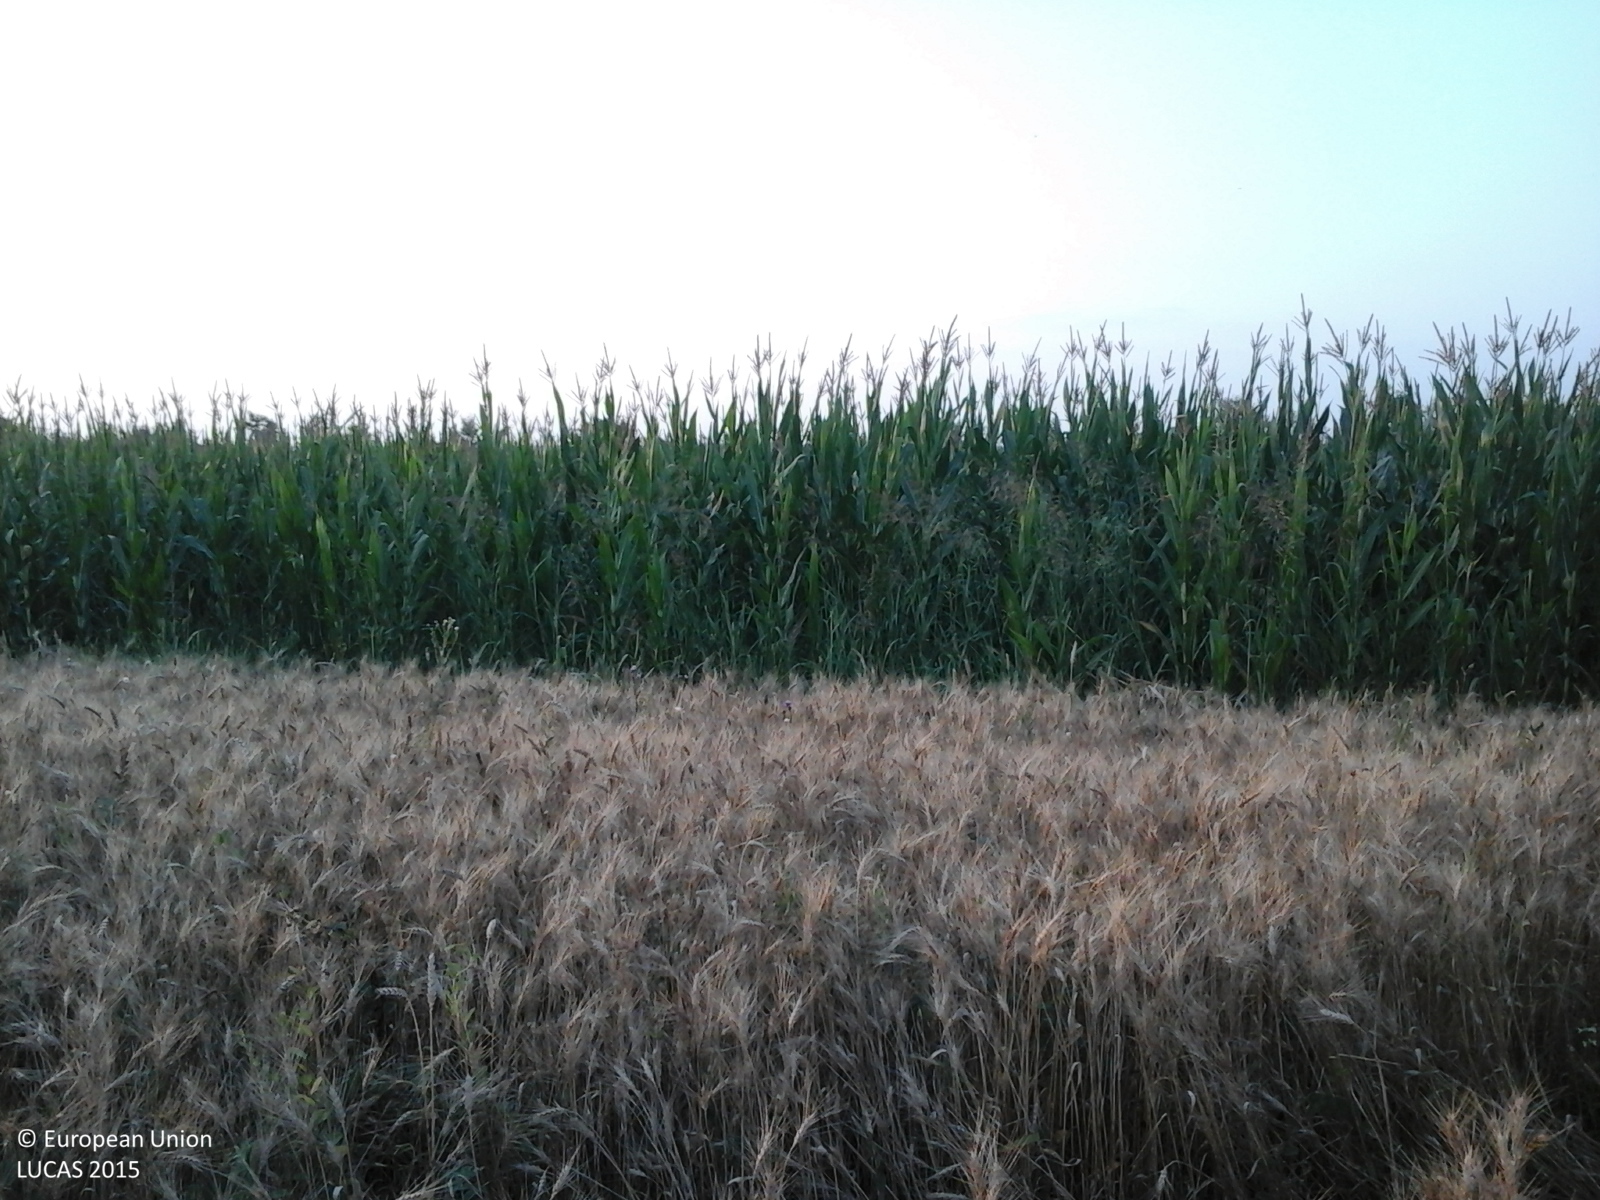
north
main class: Cropland
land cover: Barley
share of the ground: > 75 %
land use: Agriculture (excluding fallow land and kitchen gardens)
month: July
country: RO
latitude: 44.8134
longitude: 25.7162
